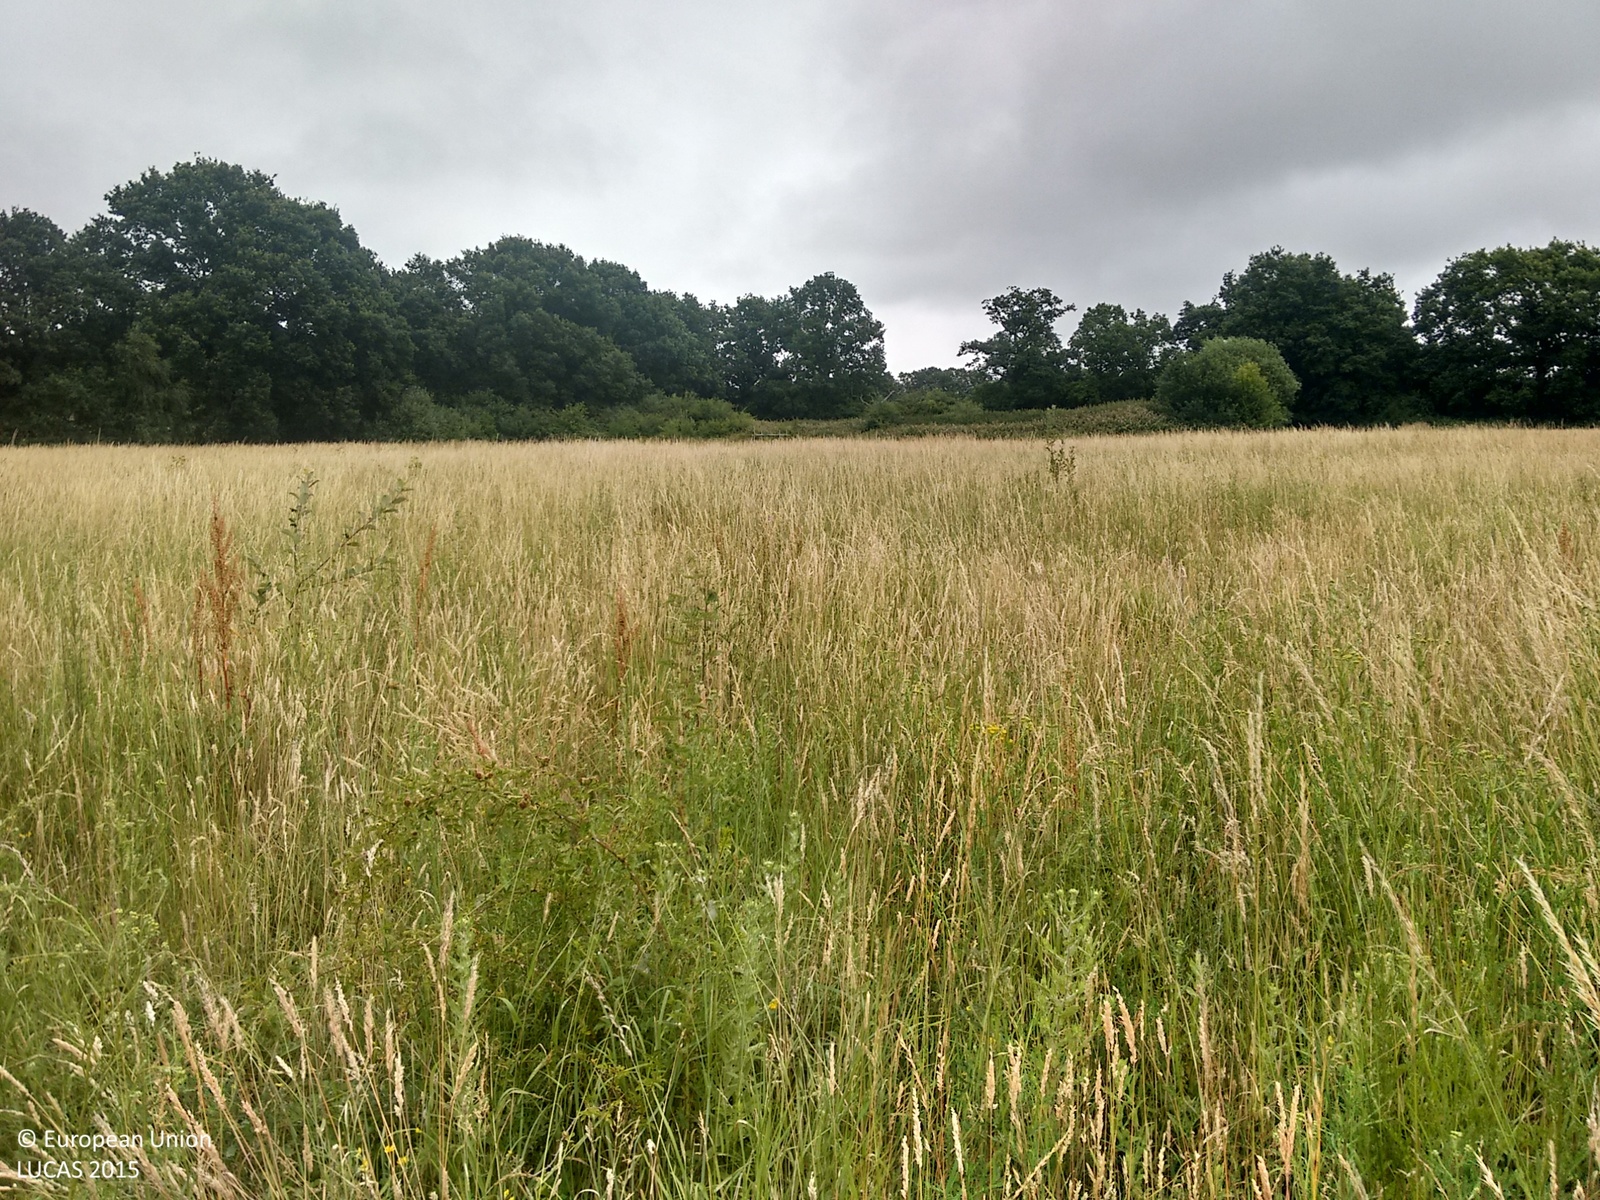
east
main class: Grassland
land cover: Grassland without tree/shrub cover
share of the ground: > 75 %
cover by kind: herbaceous plants 100 %
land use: Agriculture (excluding fallow land and kitchen gardens)
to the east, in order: Grassland without tree/shrub cover; Shrubland without tree cover; Tracks; Broadleaved woodland; Grassland without tree/shrub cover
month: July
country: GB
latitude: 51.6474
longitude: 0.4476
